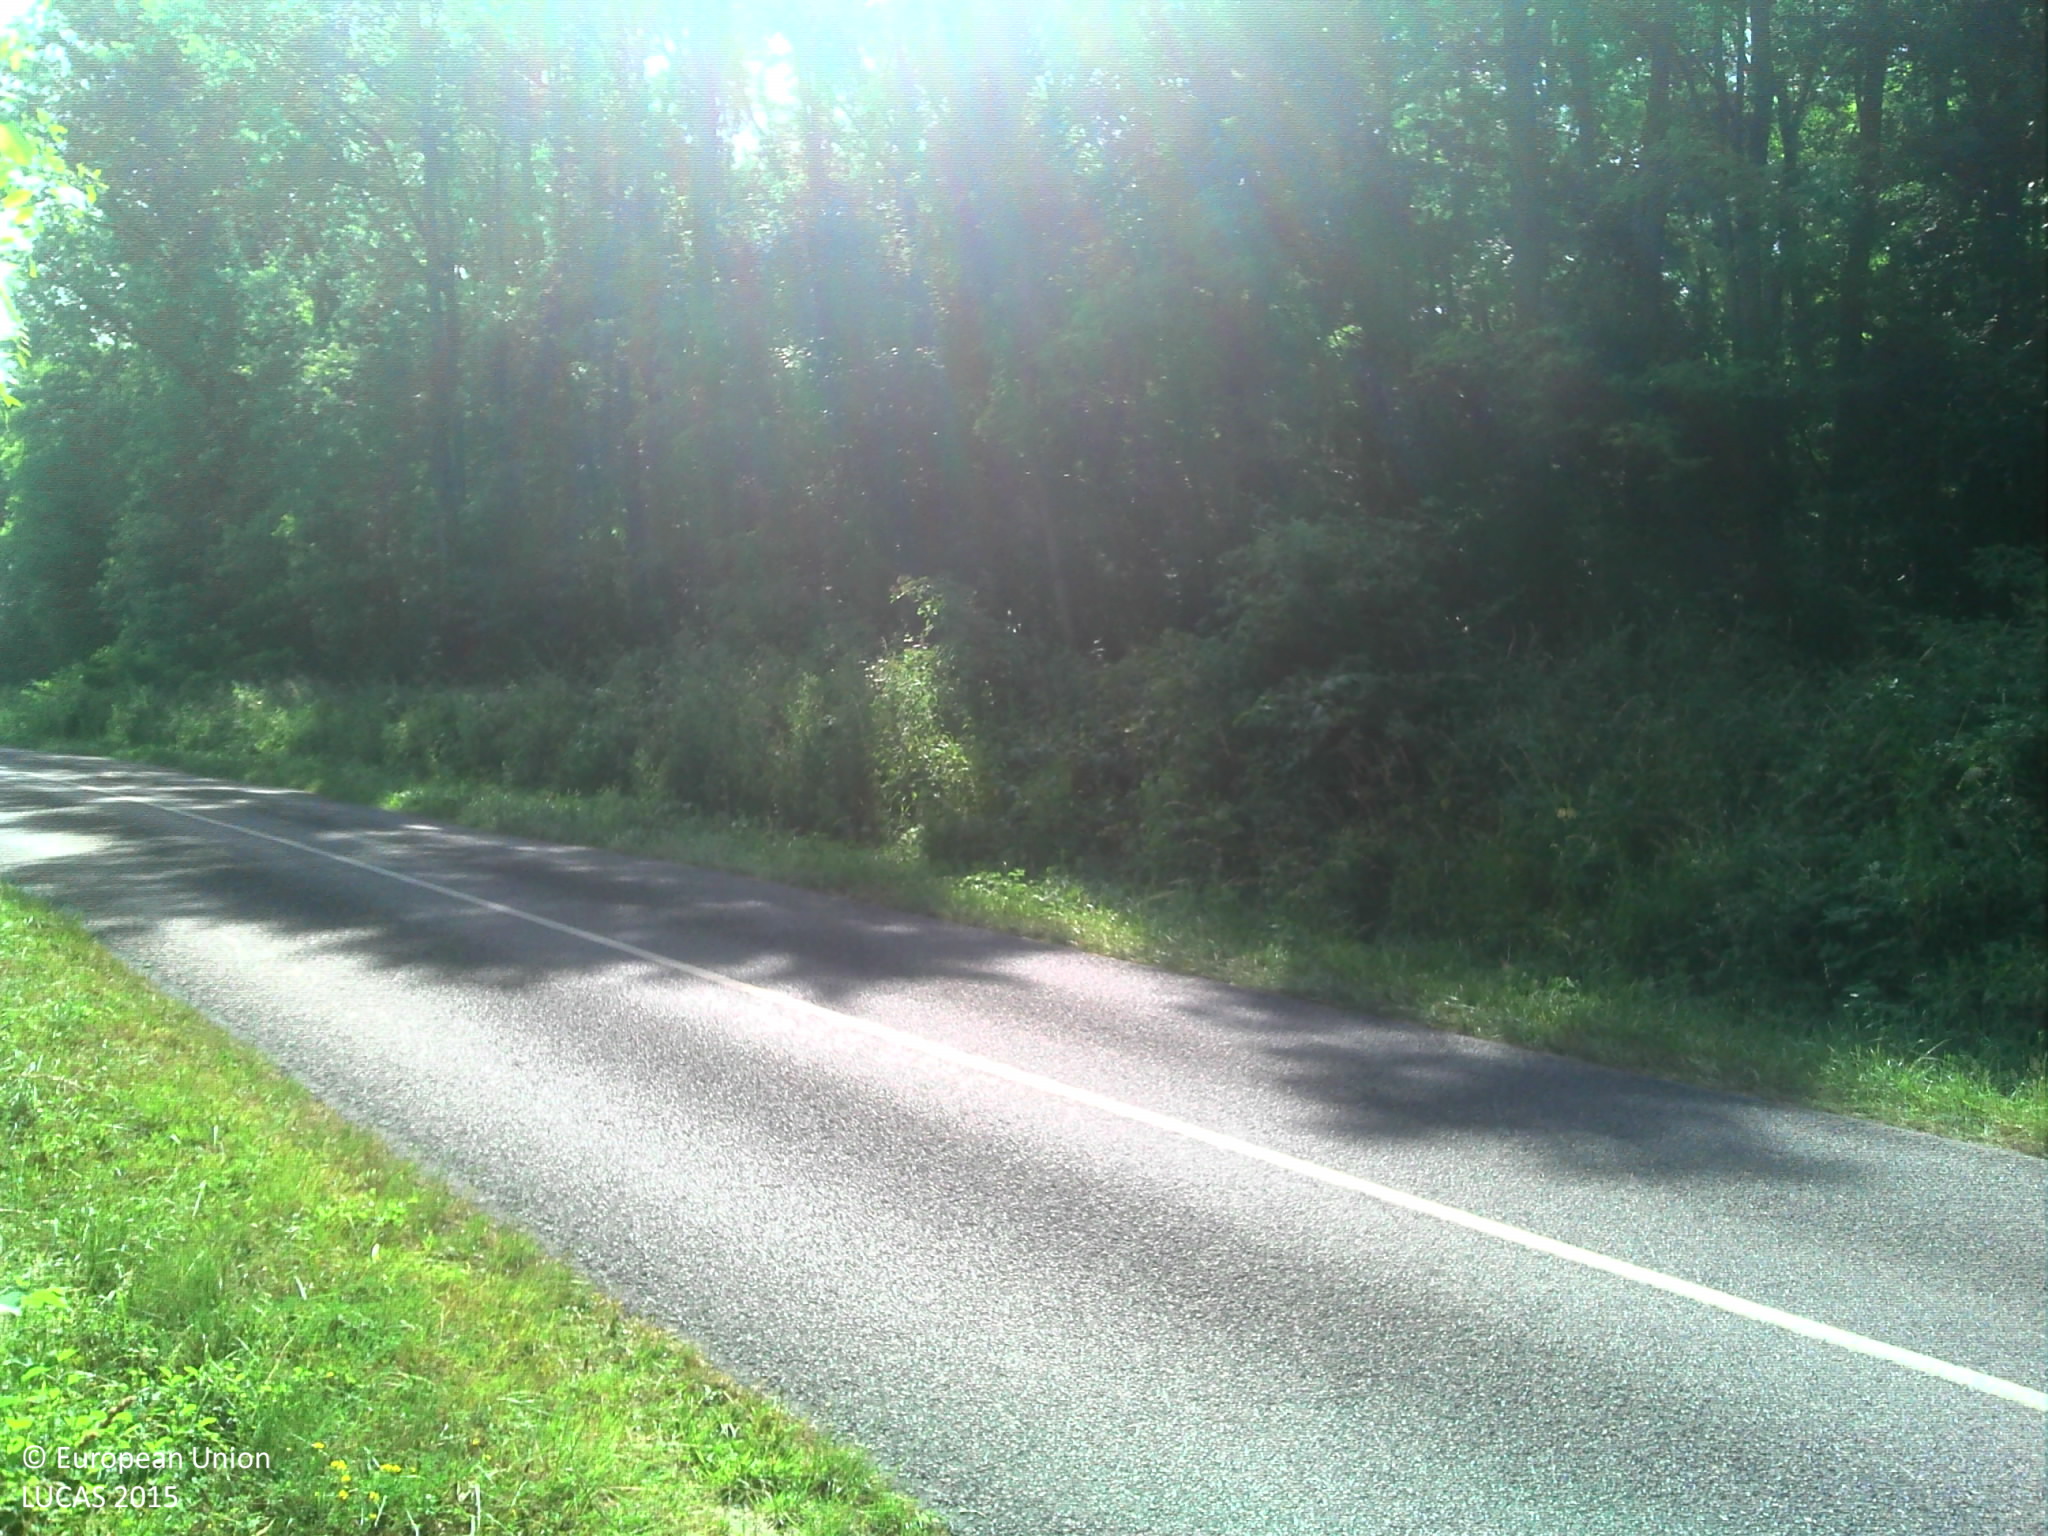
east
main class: Woodland
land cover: Broadleaved woodland
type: mesophytic deciduous forest
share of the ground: > 75 %
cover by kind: herbaceous plants 40 %, unconsolidated bare surface 40 %, broadleaved forest trees 20 %
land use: Forestry
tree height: > 5 m
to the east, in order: Broadleaved woodland; Grassland without tree/shrub cover; Broadleaved woodland; Grassland without tree/shrub cover
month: June
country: FR
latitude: 47.5024
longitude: 1.3425
